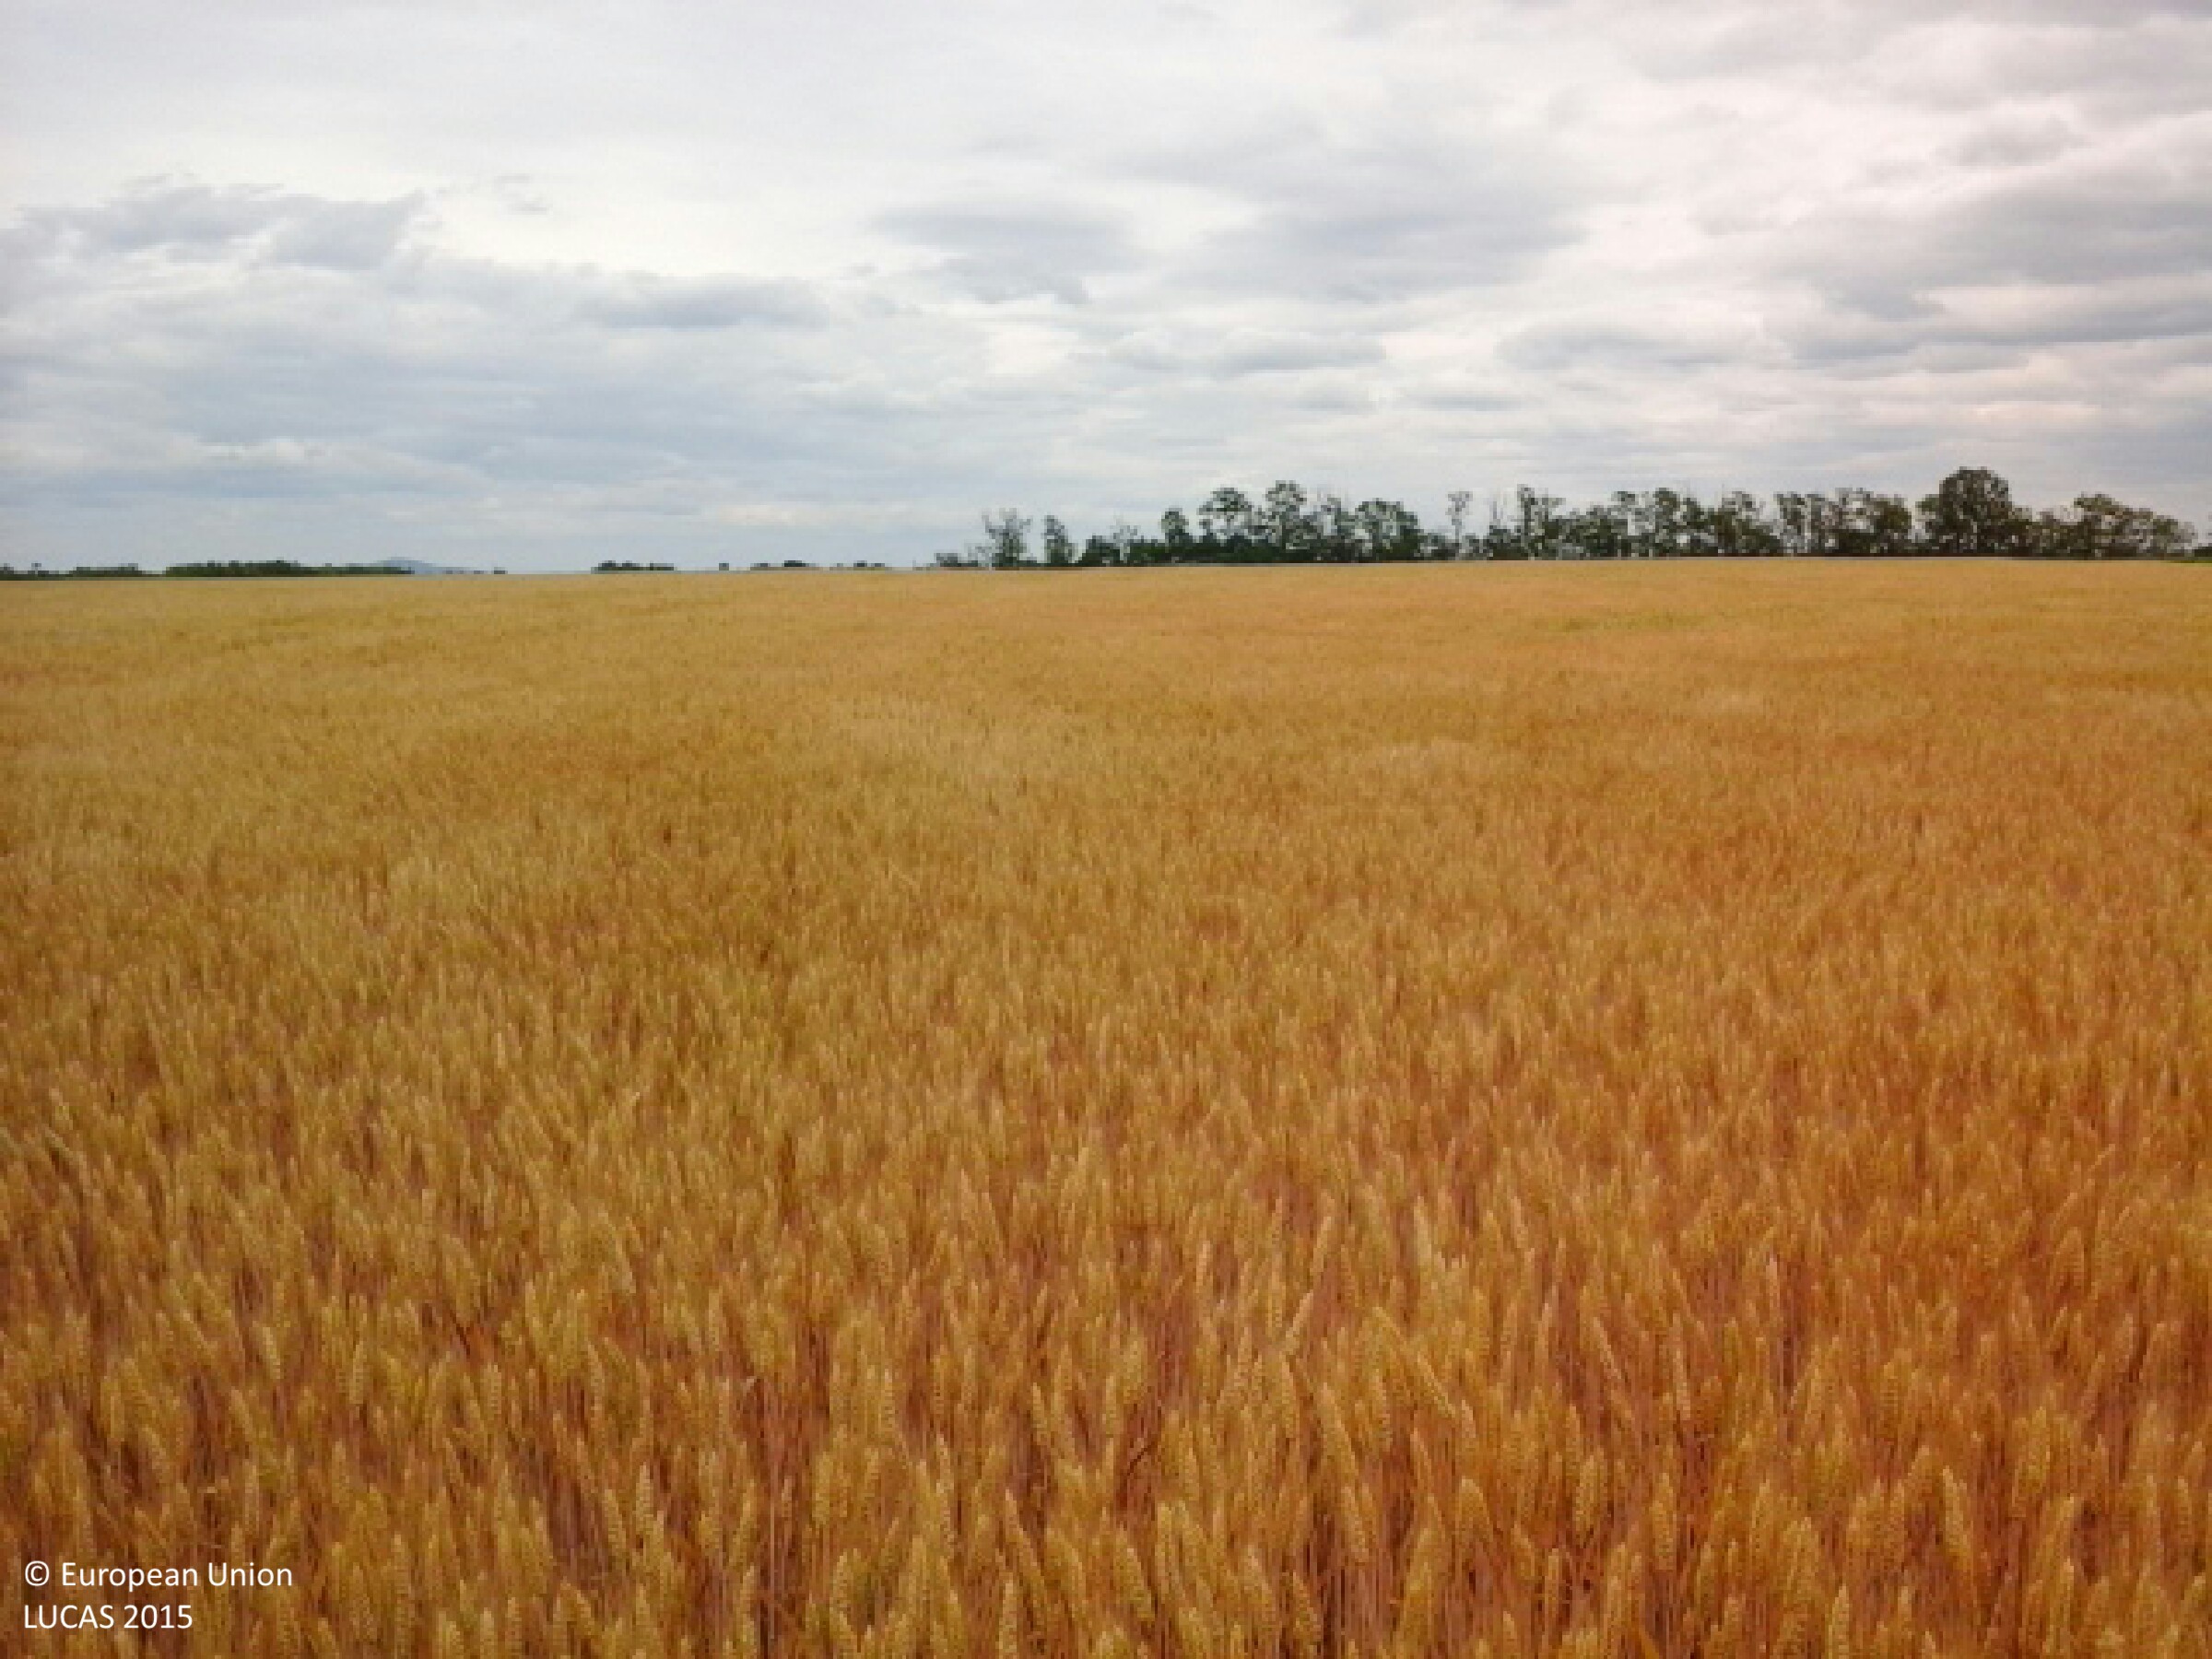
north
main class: Cropland
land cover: Triticale
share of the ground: > 75 %
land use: Agriculture (excluding fallow land and kitchen gardens)
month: June
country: HU
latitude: 47.9353
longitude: 21.4354
